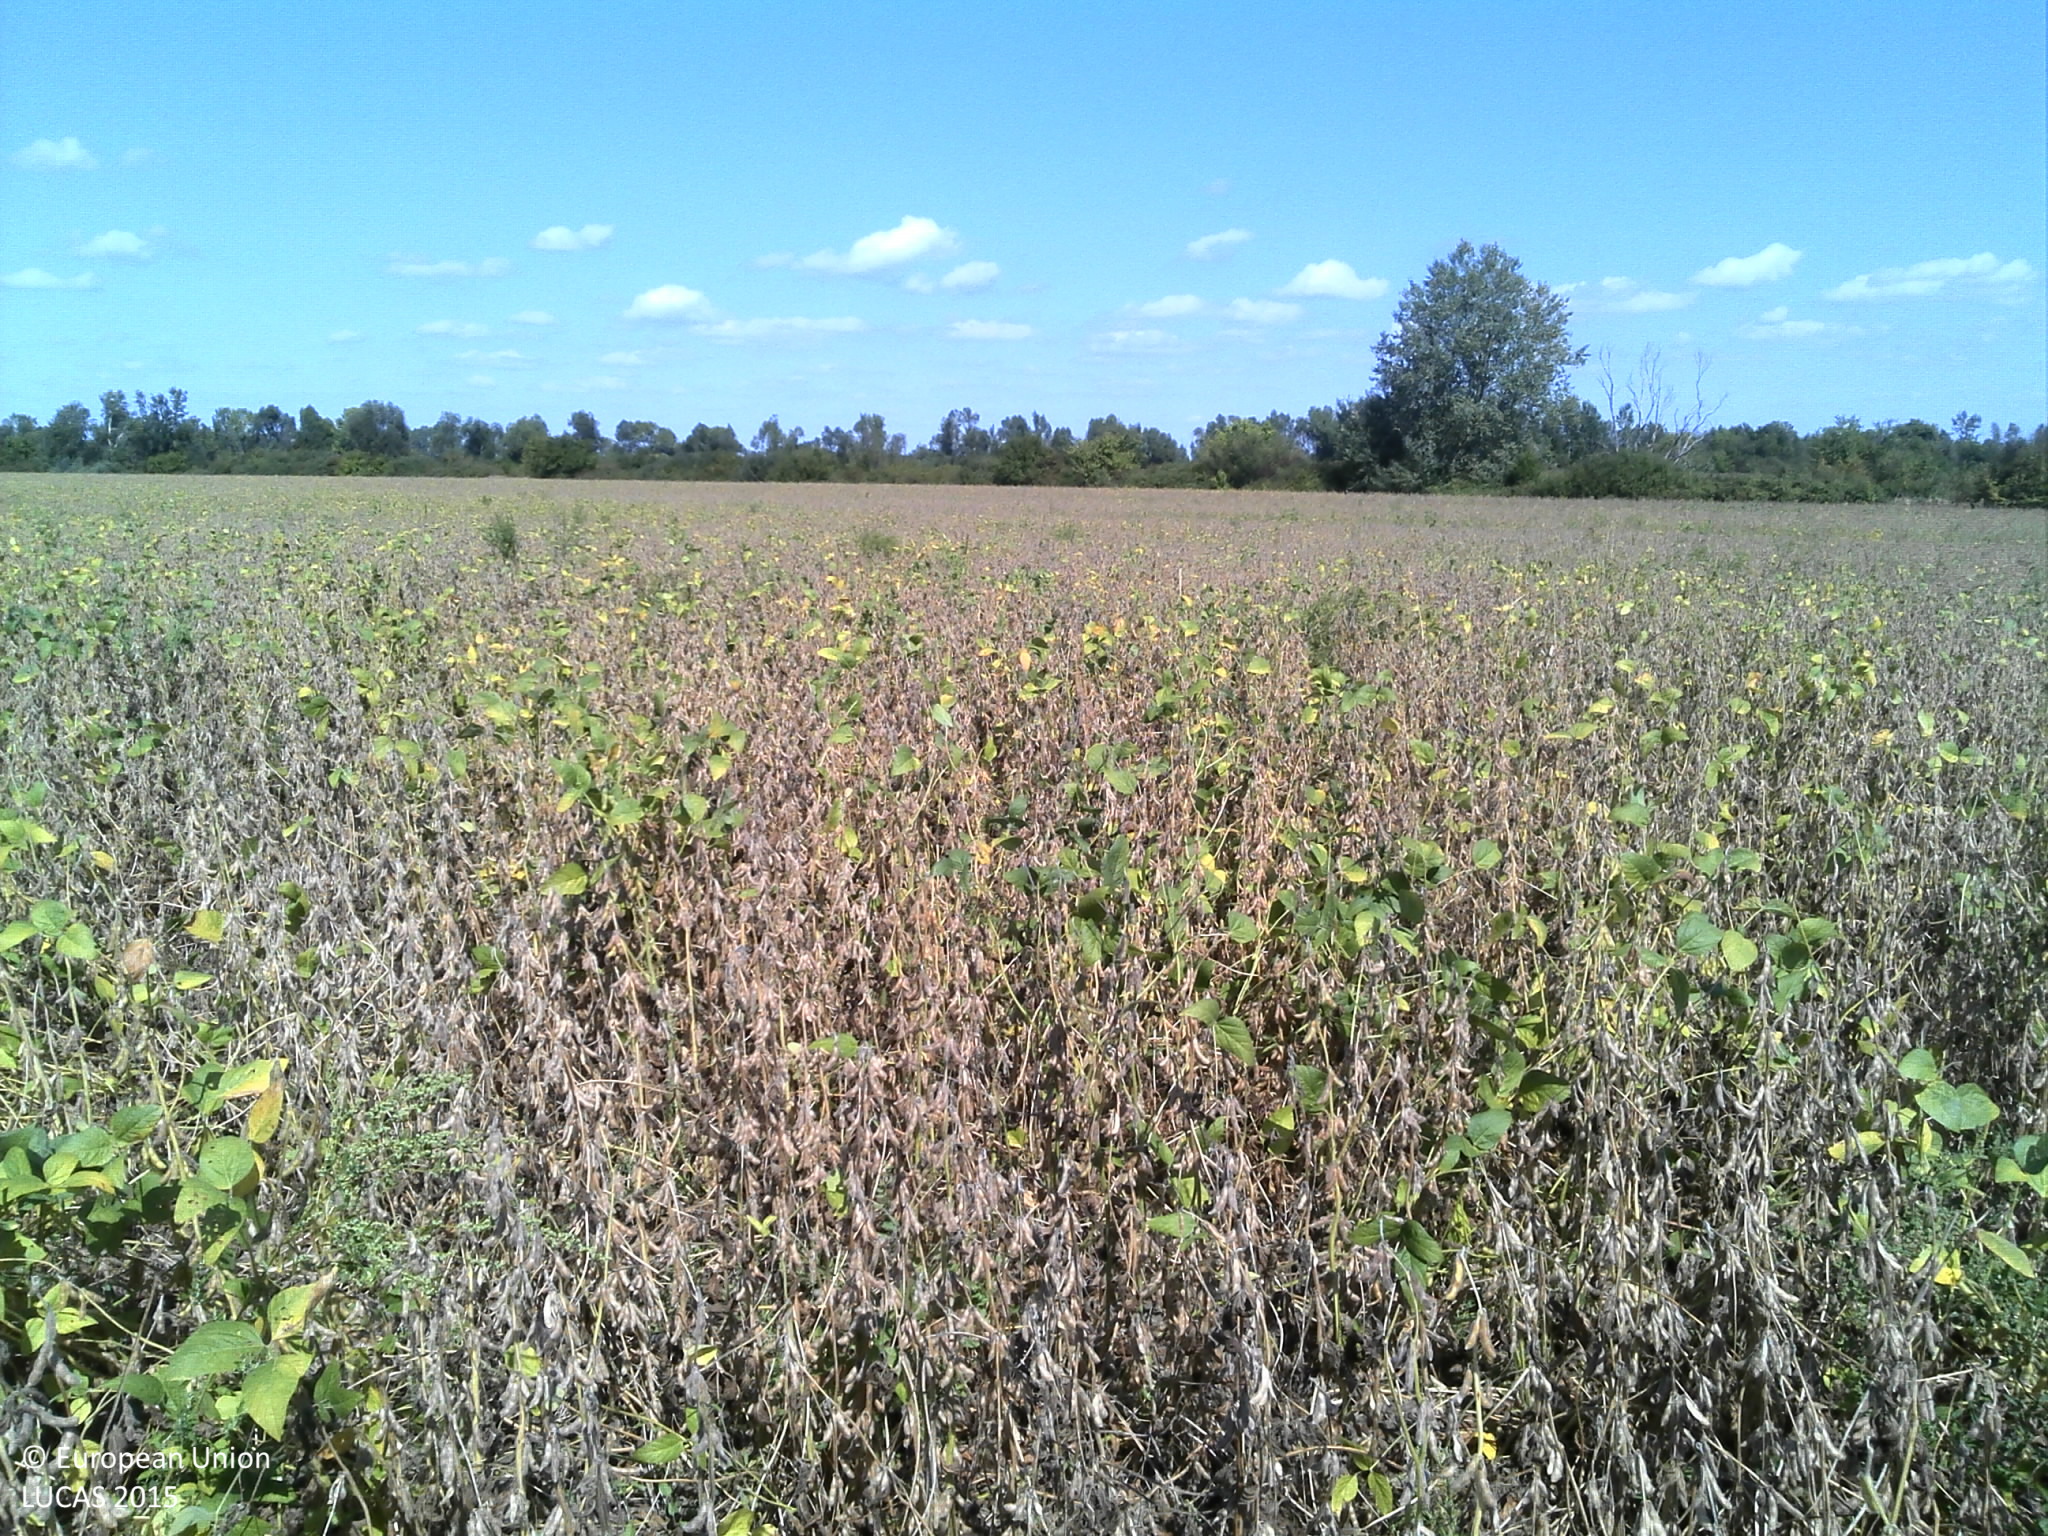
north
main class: Cropland
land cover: Soya
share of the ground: > 75 %
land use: Agriculture (excluding fallow land and kitchen gardens)
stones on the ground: < 10 %
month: September
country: HR
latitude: 44.9367
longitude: 19.0166
